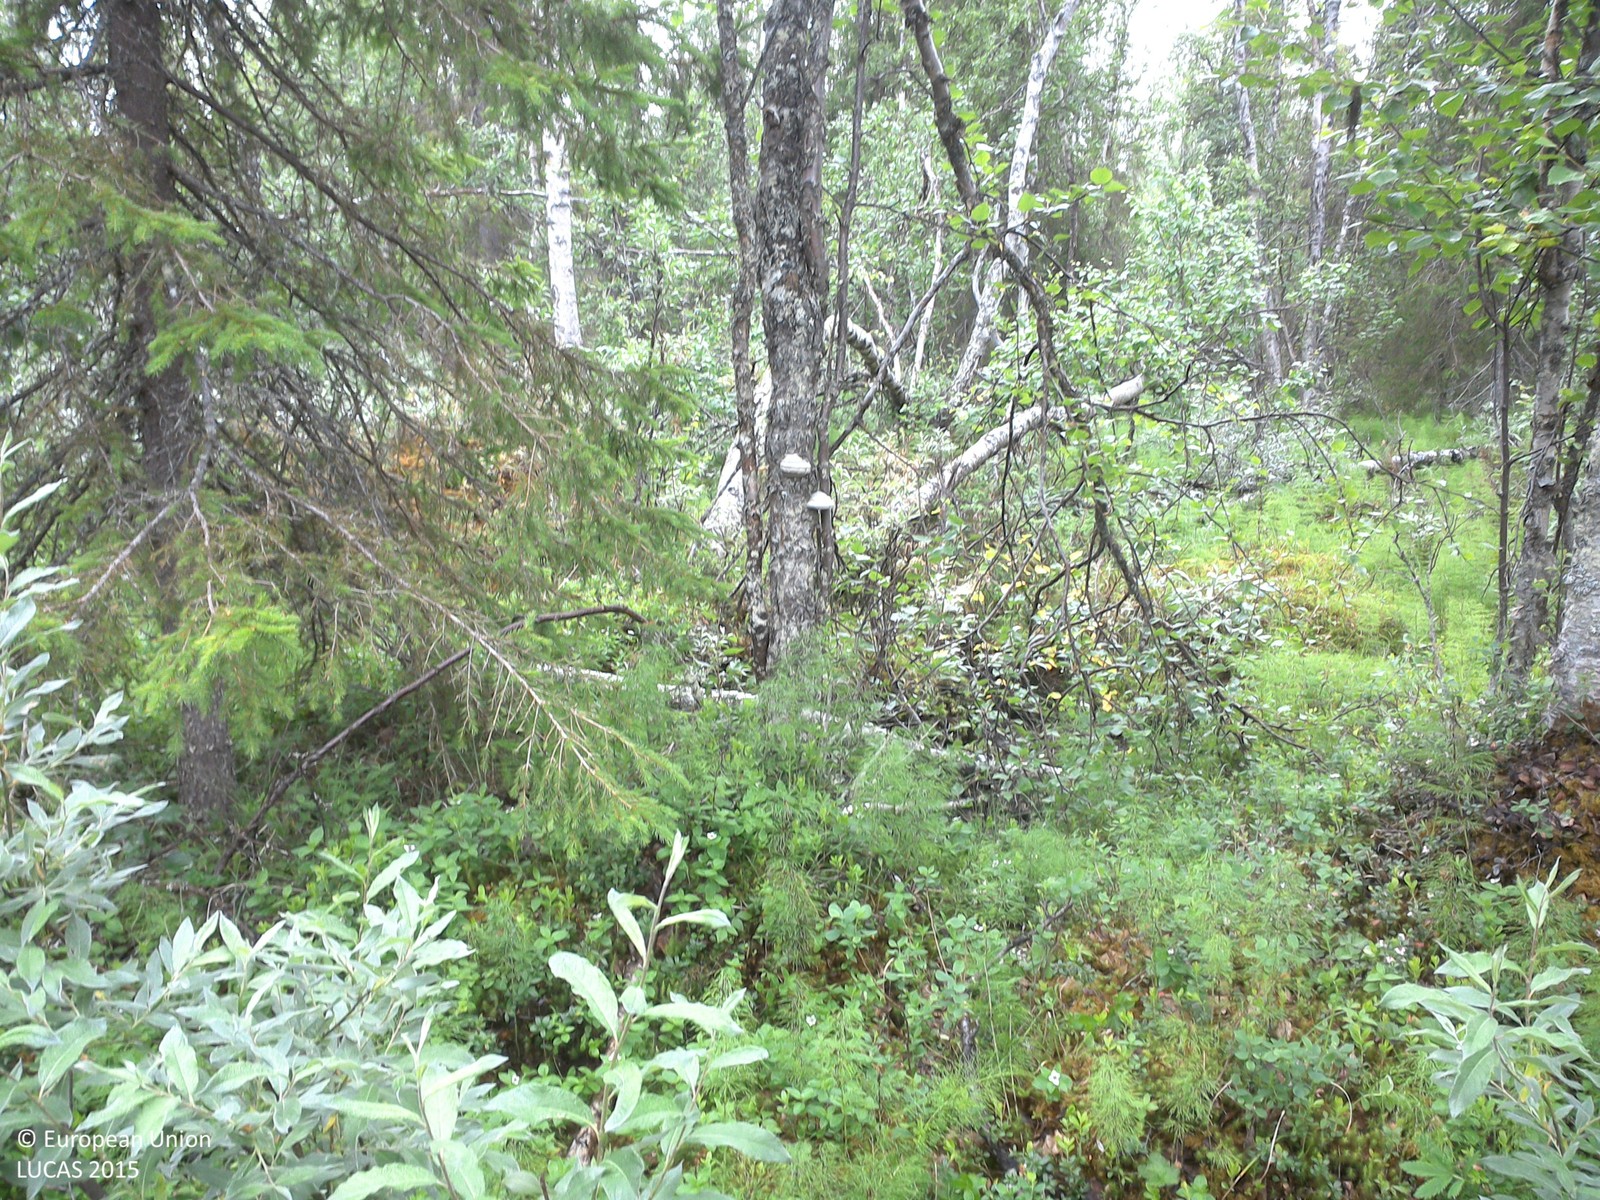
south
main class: Woodland
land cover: Spruce dominated mixed woodland
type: boreal forest
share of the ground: 25 - 50 %
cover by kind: shrubs 35 %, herbaceous plants 25 %, coniferous forest trees 20 %, broadleaved forest trees 15 %, lichens and mosses 5 %
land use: Forestry
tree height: > 5 m
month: July
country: SE
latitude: 67.7530
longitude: 23.0965
